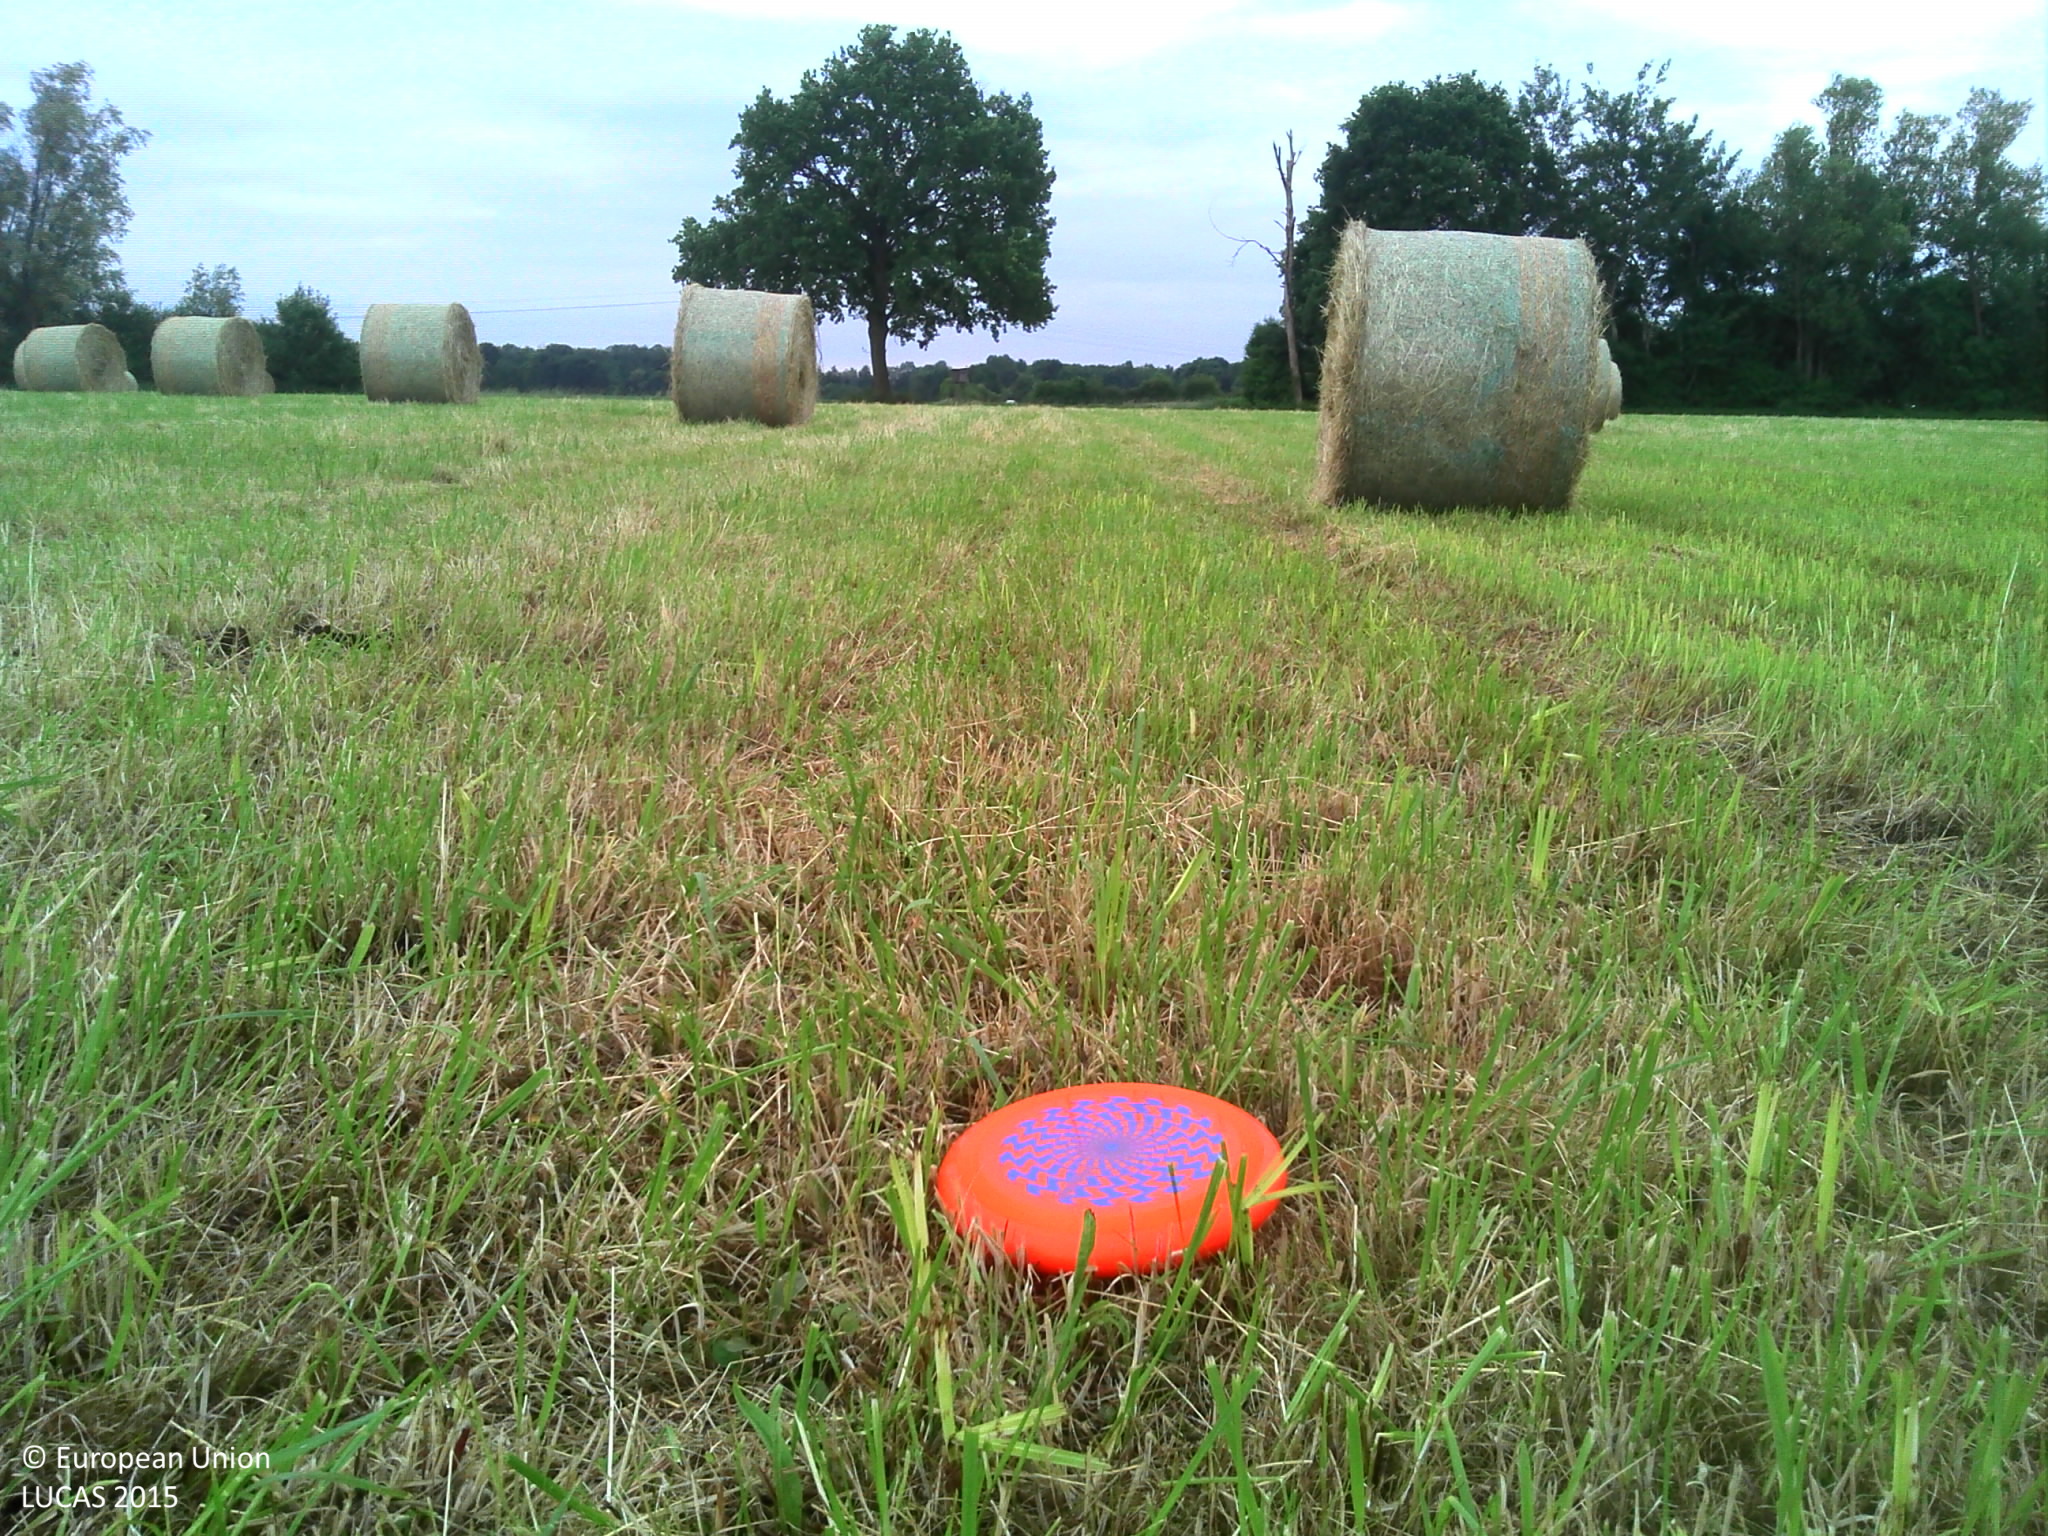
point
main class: Grassland
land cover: Grassland without tree/shrub cover
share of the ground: > 75 %
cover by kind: herbaceous plants 100 %
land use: Agriculture (excluding fallow land and kitchen gardens)
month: June
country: FR
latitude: 48.4856
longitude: 7.6061
